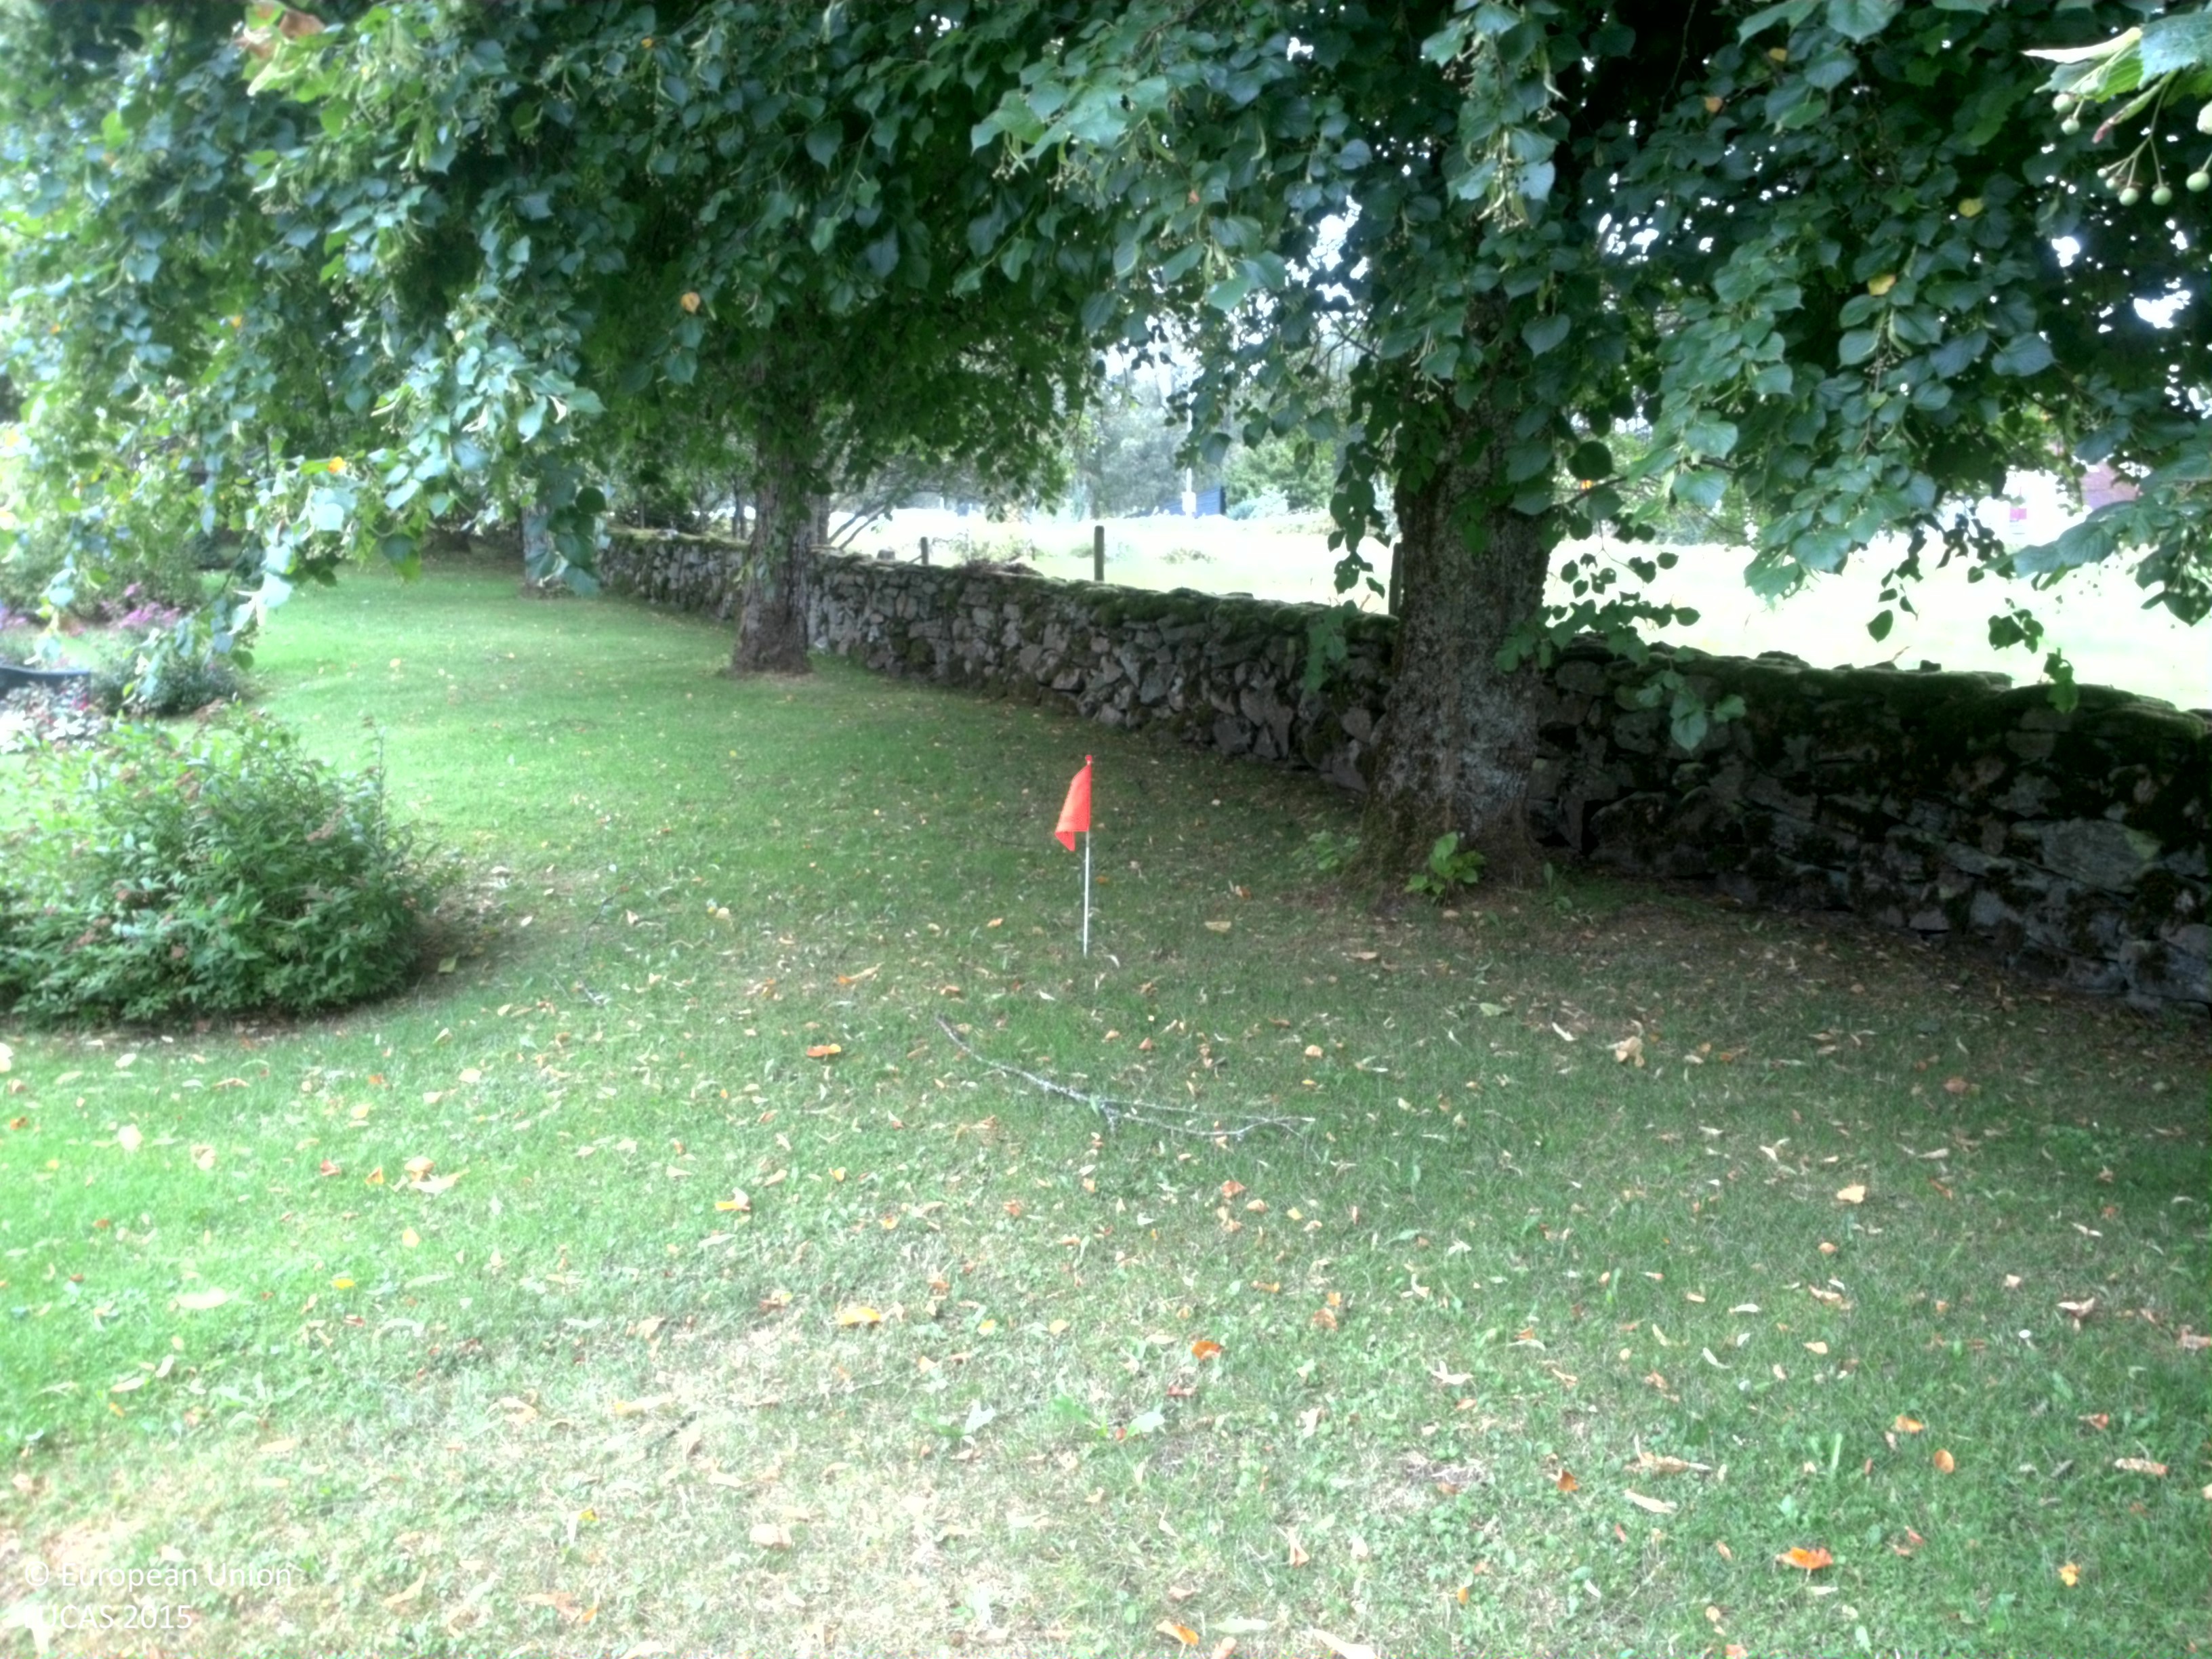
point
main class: Grassland
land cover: Grassland without tree/shrub cover
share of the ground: > 75 %
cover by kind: herbaceous plants 100 %
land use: Community services
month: August
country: SE
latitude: 57.8375
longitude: 13.2795
